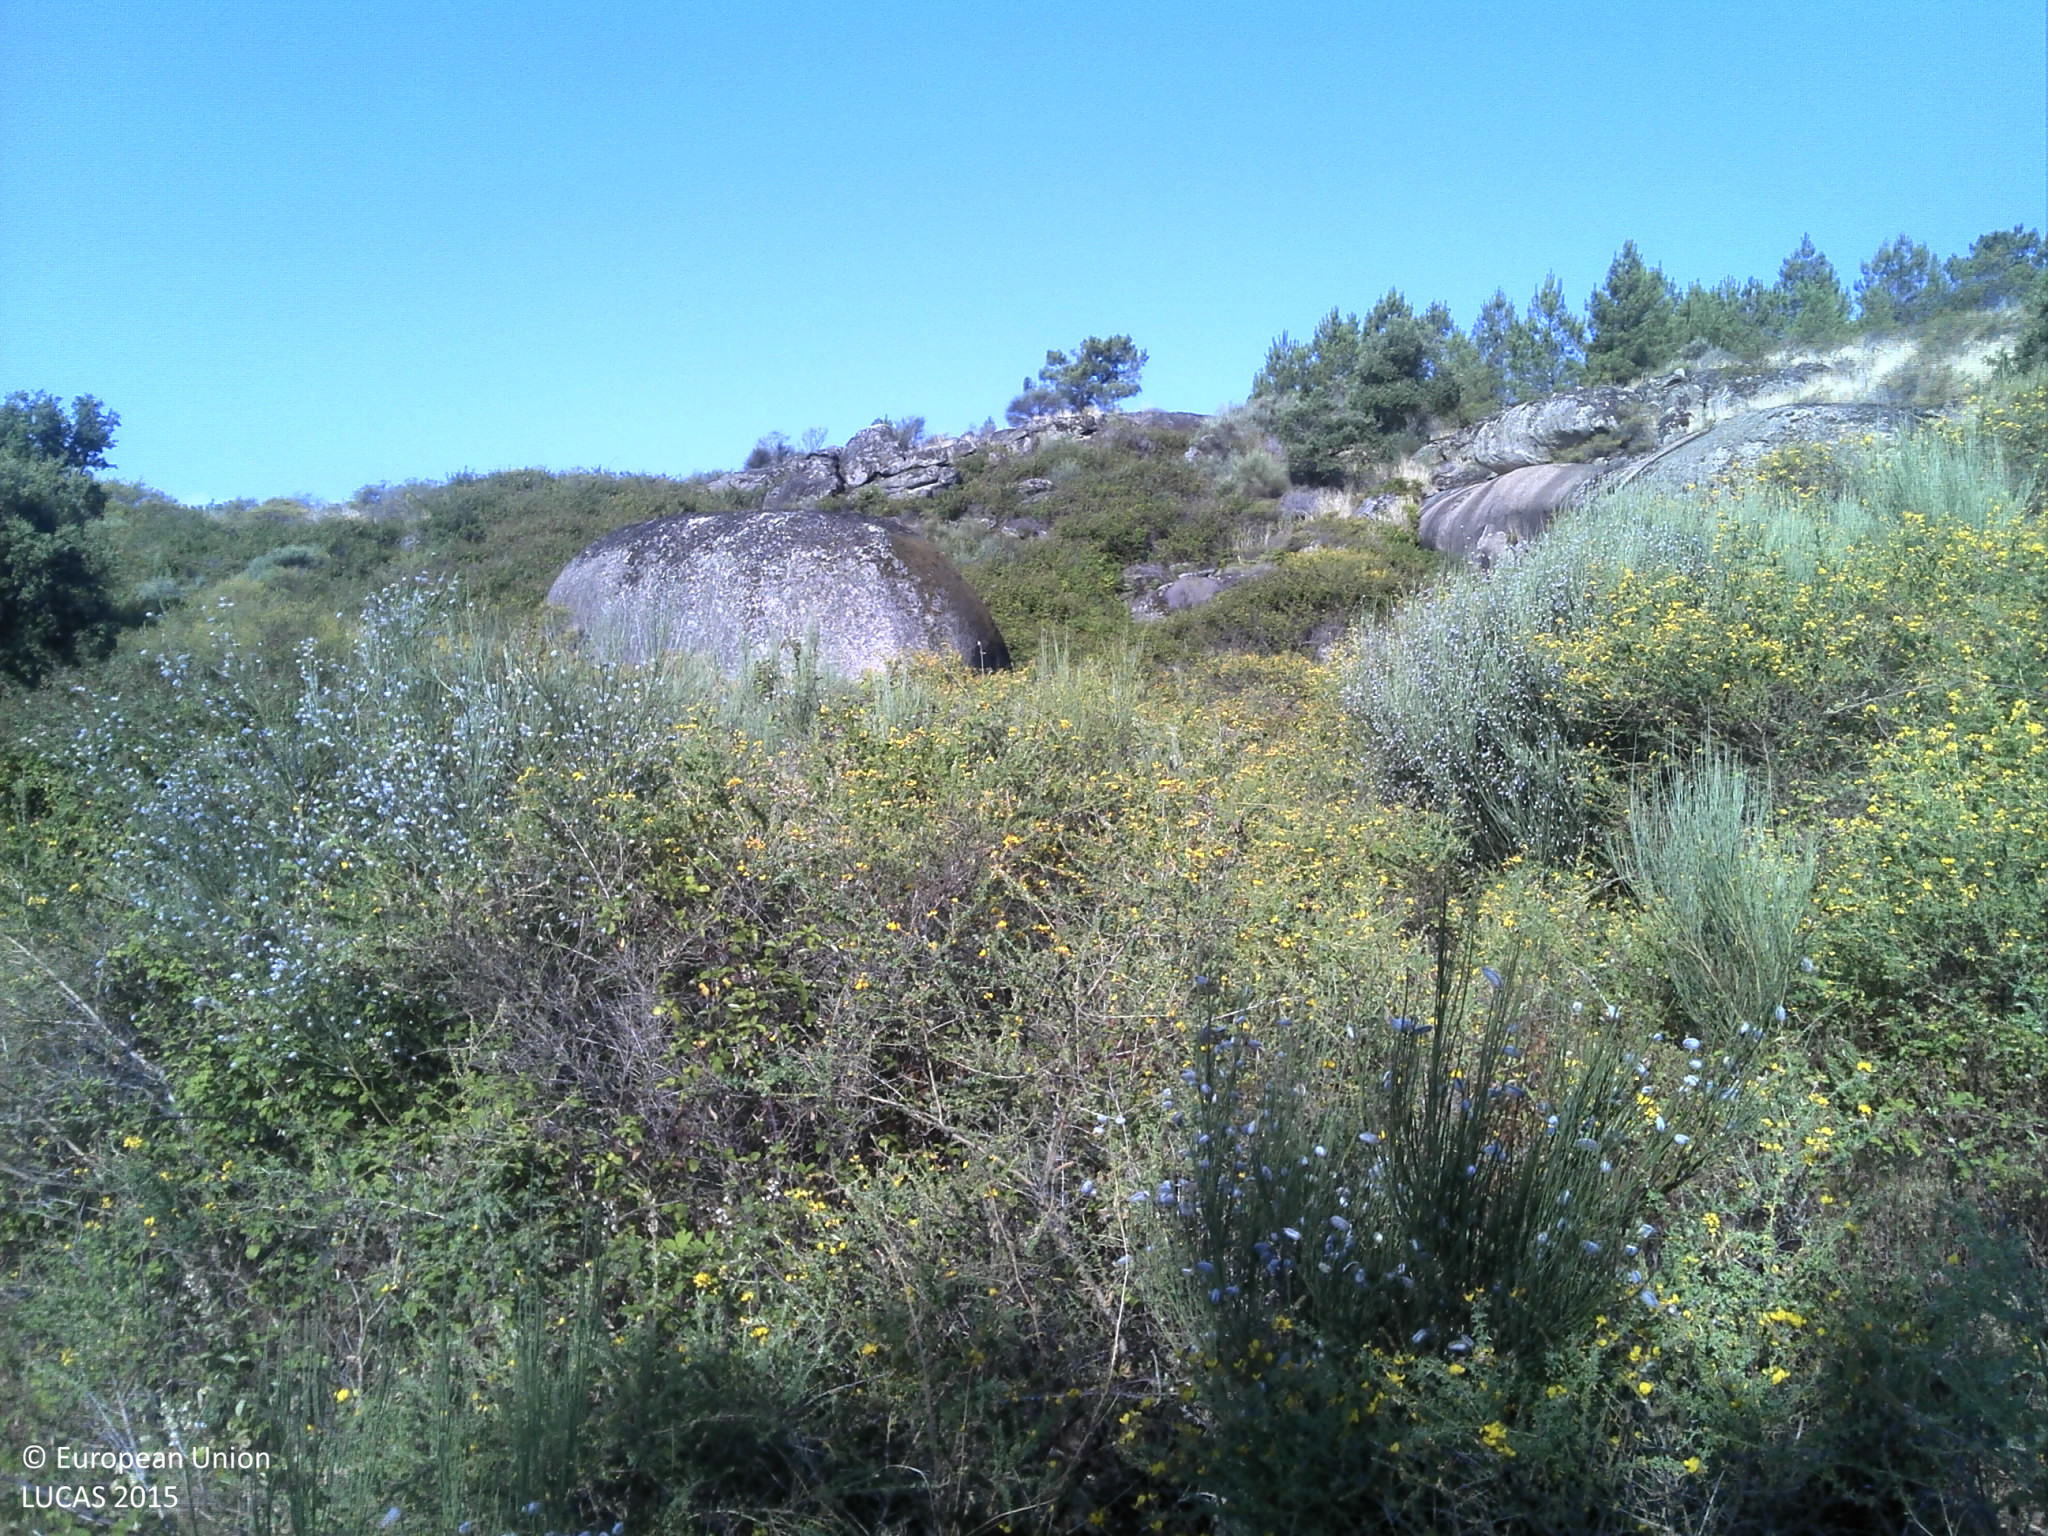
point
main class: Shrubland
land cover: Shrubland with sparse tree cover
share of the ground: 50 - 75 %
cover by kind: shrubs 70 %, herbaceous plants 15 %, coniferous forest trees 5 %, unconsolidated bare surface 5 %
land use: Semi-natural and natural areas not in use
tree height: < 5 m
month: June
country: PT
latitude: 40.0849
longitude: -7.1836
